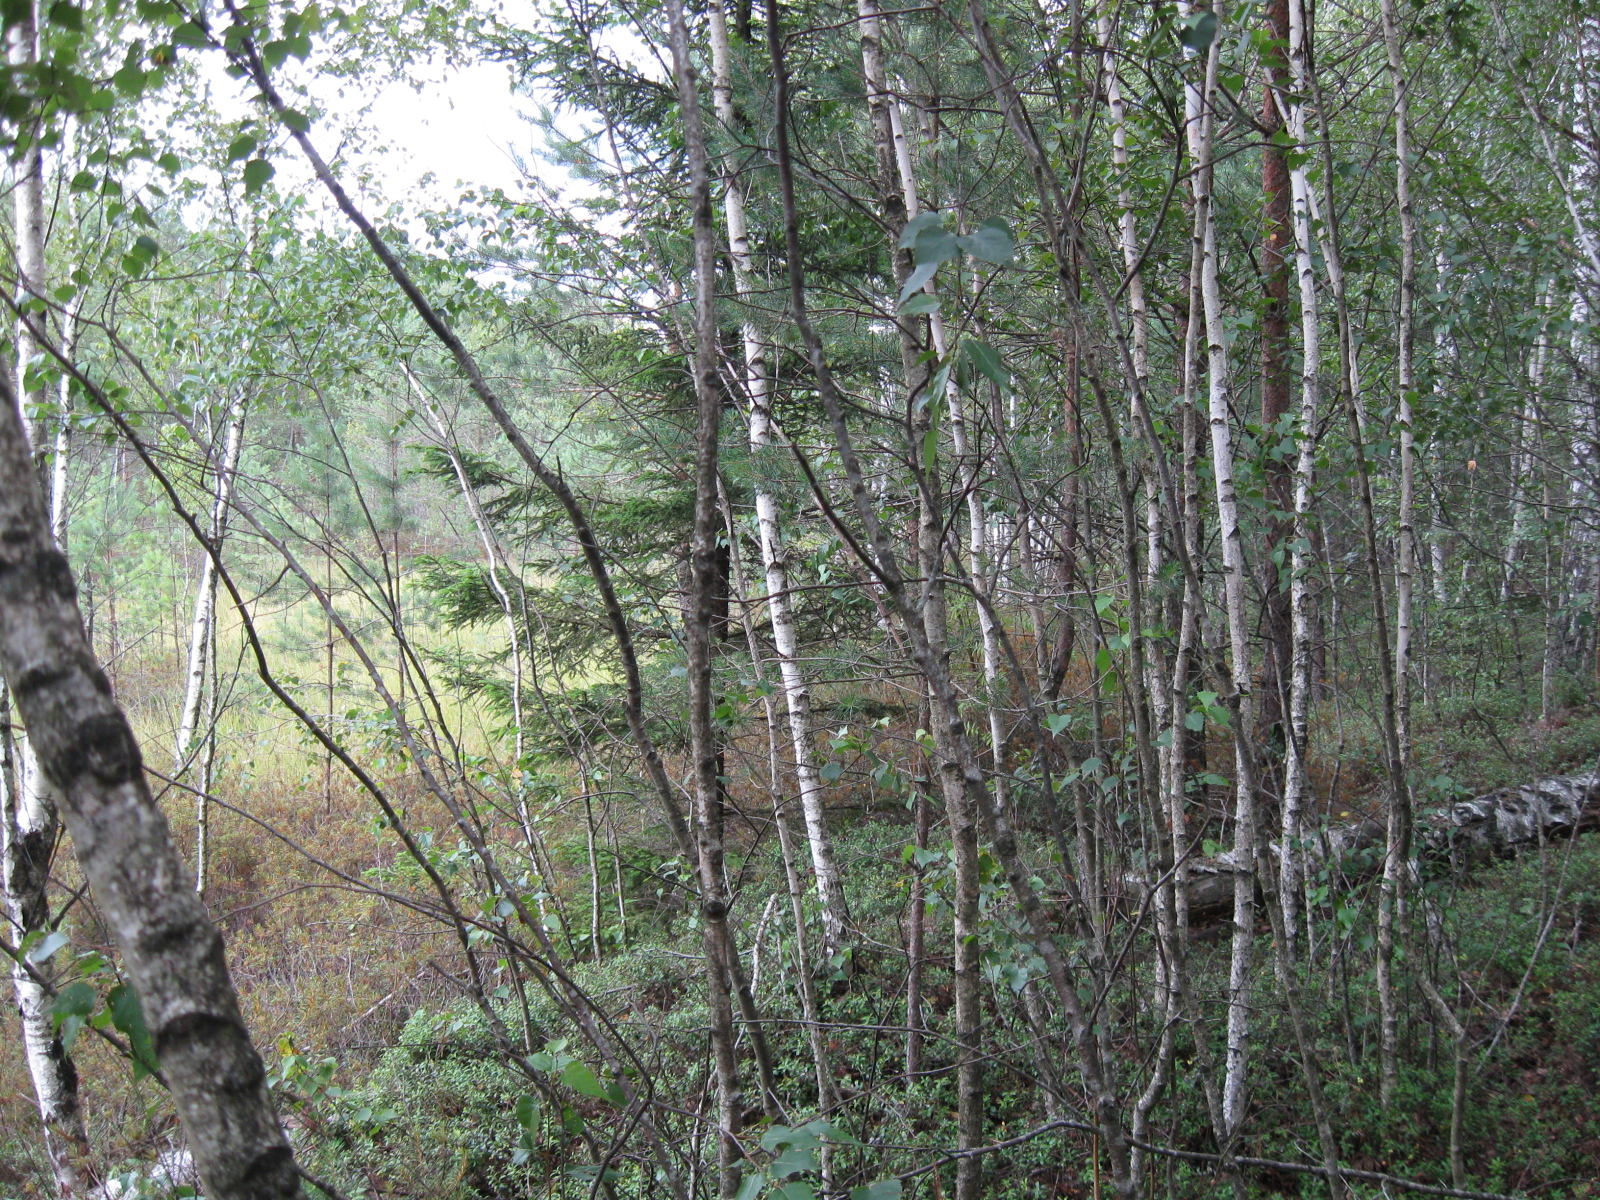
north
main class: Woodland
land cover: Pine dominated mixed woodland
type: mire and swamp forests
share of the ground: > 75 %
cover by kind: broadleaved forest trees 55 %, coniferous forest trees 25 %, herbaceous plants 15 %, shrubs 5 %
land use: Forestry
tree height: > 5 m
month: July
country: LT
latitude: 54.8754
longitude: 23.5947
